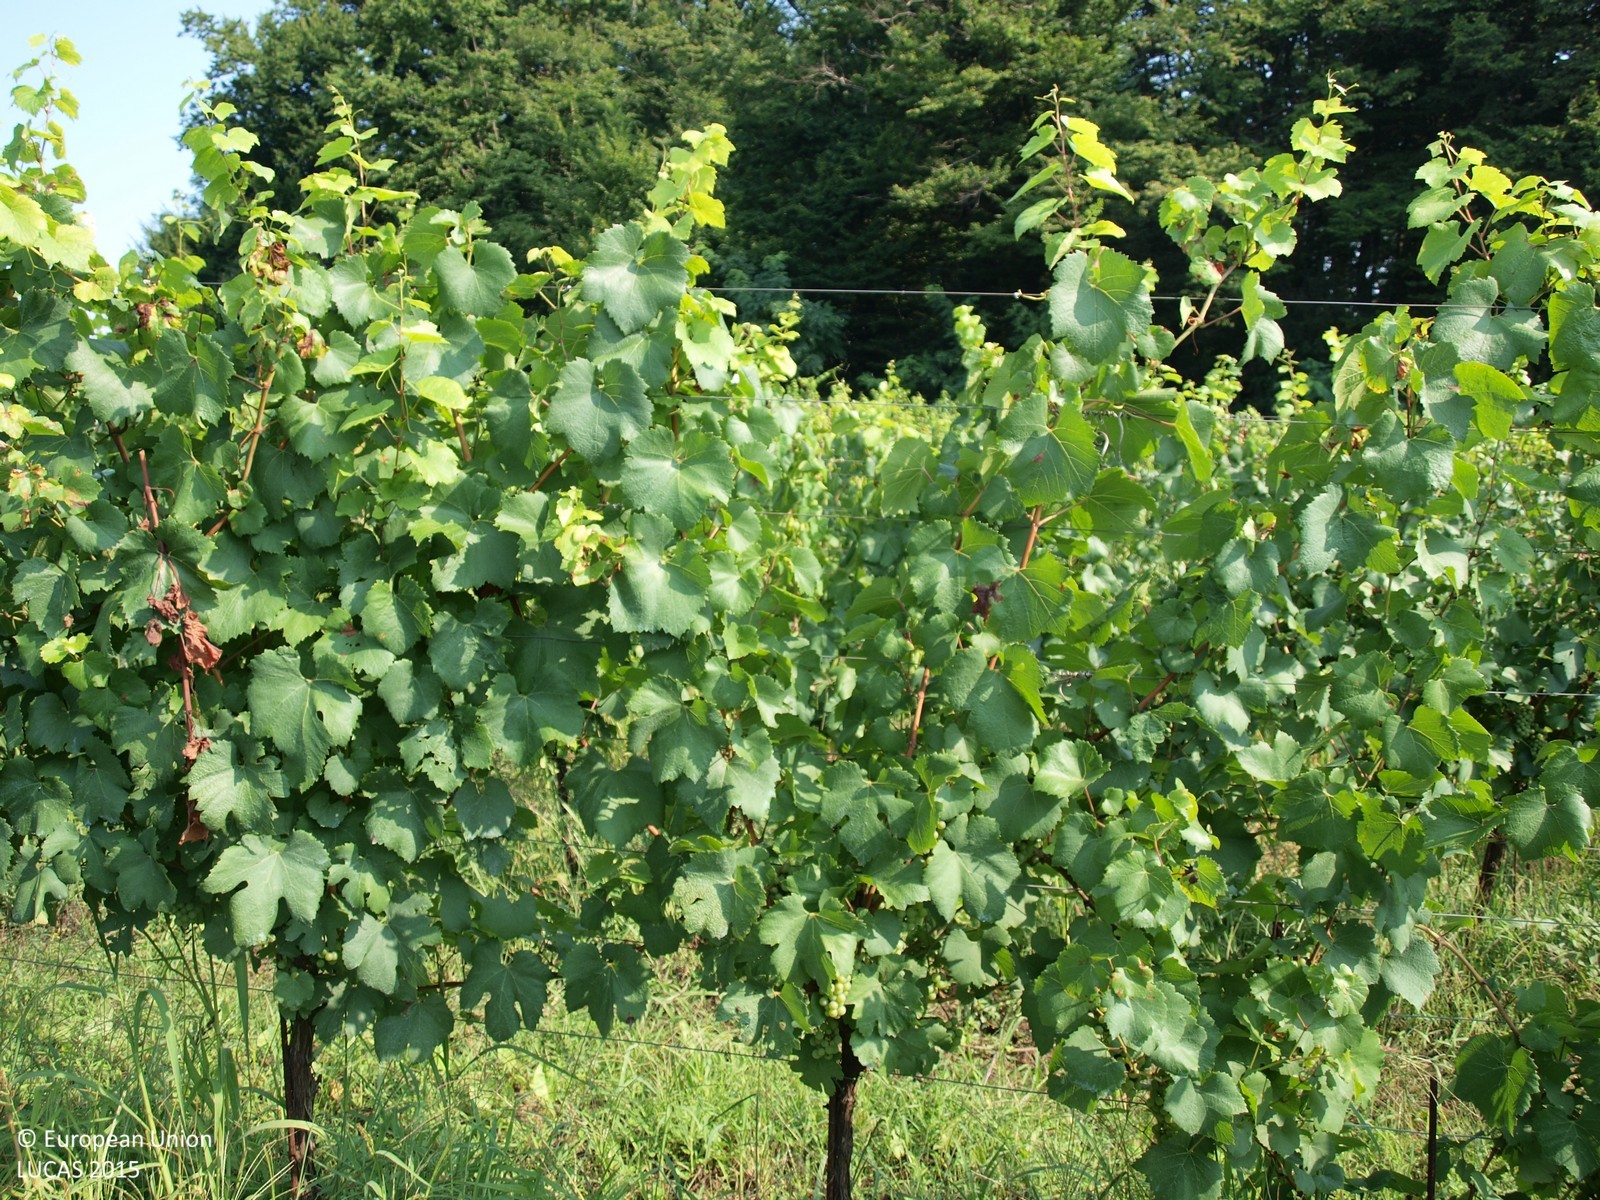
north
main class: Cropland
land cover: Vineyards
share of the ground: 50 - 75 %
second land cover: Grassland without tree/shrub cover
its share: 50 - 75 %
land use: Agriculture (excluding fallow land and kitchen gardens)
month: August
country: HR
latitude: 45.9241
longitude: 16.4080
